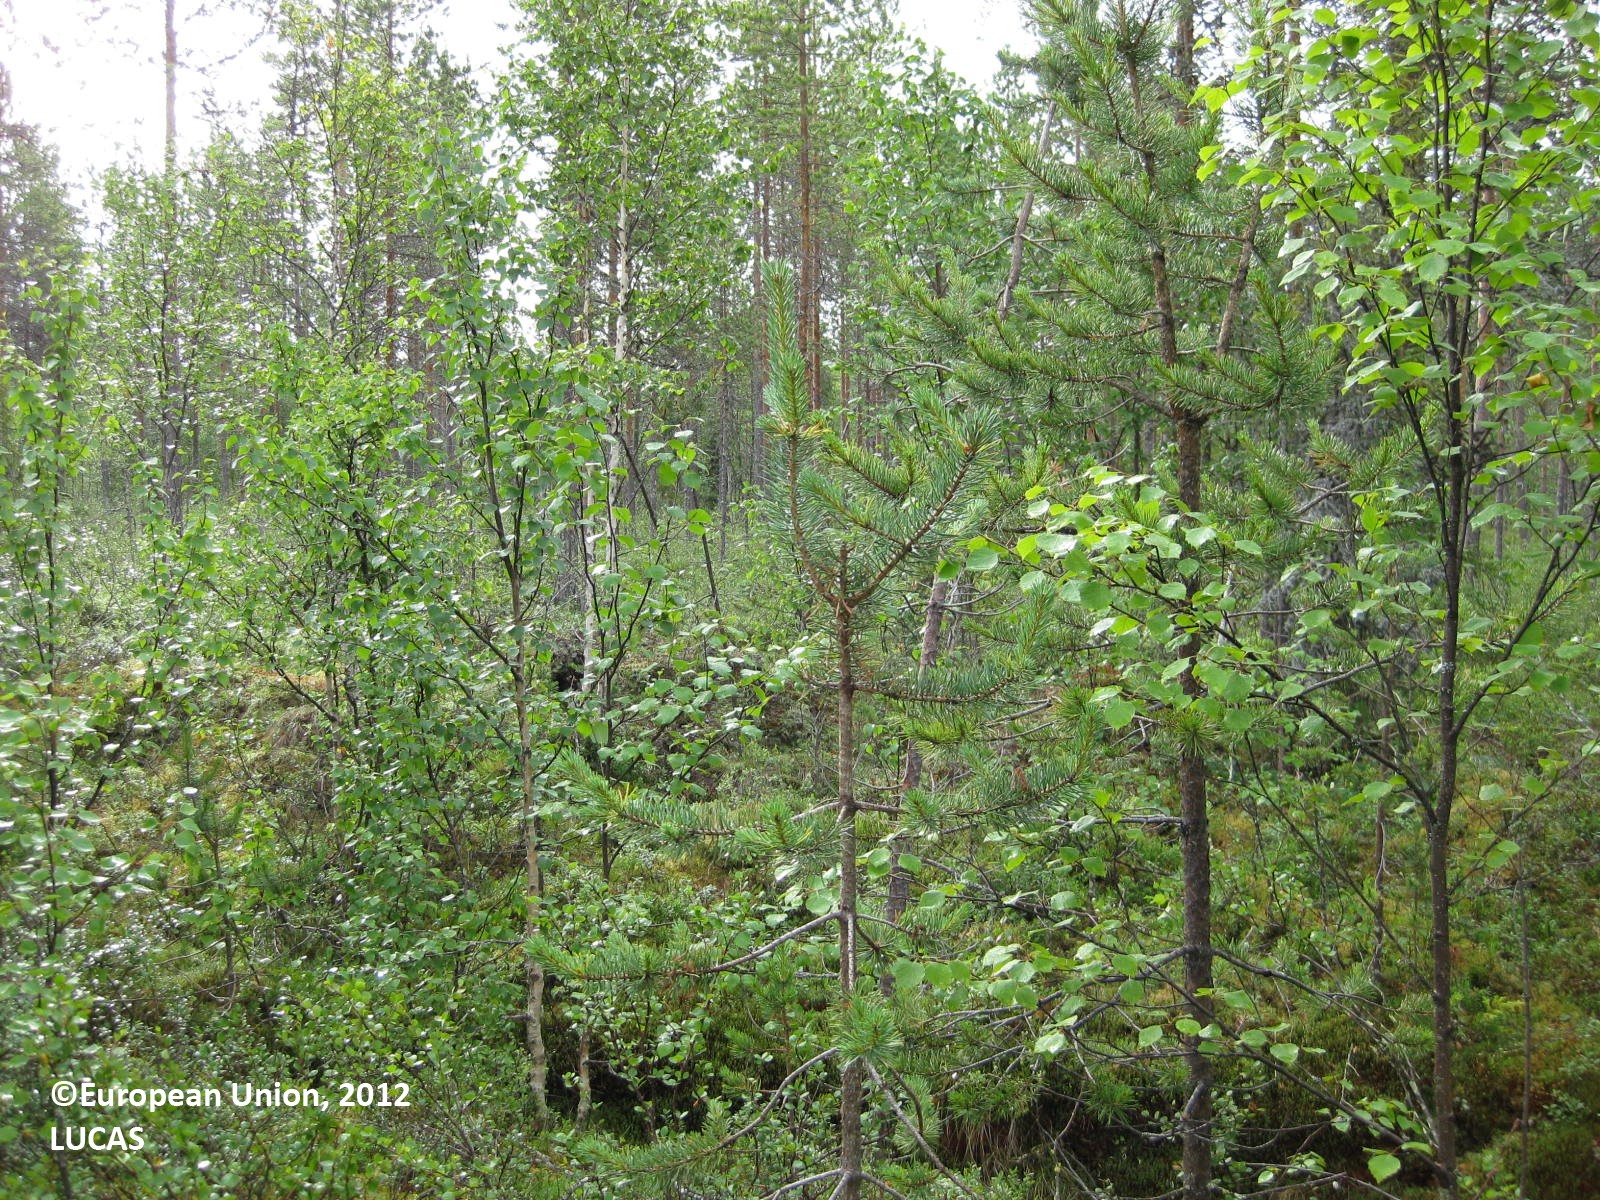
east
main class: Woodland
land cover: Pine dominated mixed woodland
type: boreal forest
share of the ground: > 75 %
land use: Forestry
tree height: > 5 m
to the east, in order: Pine dominated mixed woodland; Ditches and canals; Pine dominated coniferous woodland; Abandoned hedges; Ditches and canals; Abandoned hedges; Pine dominated coniferous woodland; Ditches and canals; Spruce dominated mixed woodland; Ditches and canals; Spruce dominated mixed woodland; Ditches and canals; Spruce dominated mixed woodland; Ditches and canals; Spruce dominated mixed woodland; Ditches and canals; Spruce dominated mixed woodland; Ditches and canals; Spruce dominated mixed woodland; Ditches and canals; Spruce dominated mixed woodland; Ditches and canals; Spruce dominated mixed woodland; Ditches and canals; Spruce dominated mixed woodland; Ditches and canals; Spruce dominated mixed woodland; Ditches and canals; Spruce dominated mixed woodland; Ditches and canals; Spruce dominated mixed woodland; Rivers and streams; Spruce dominated mixed woodland; Fences; Other mixed woodland
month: July
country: FI
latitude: 65.6137
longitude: 28.3214
